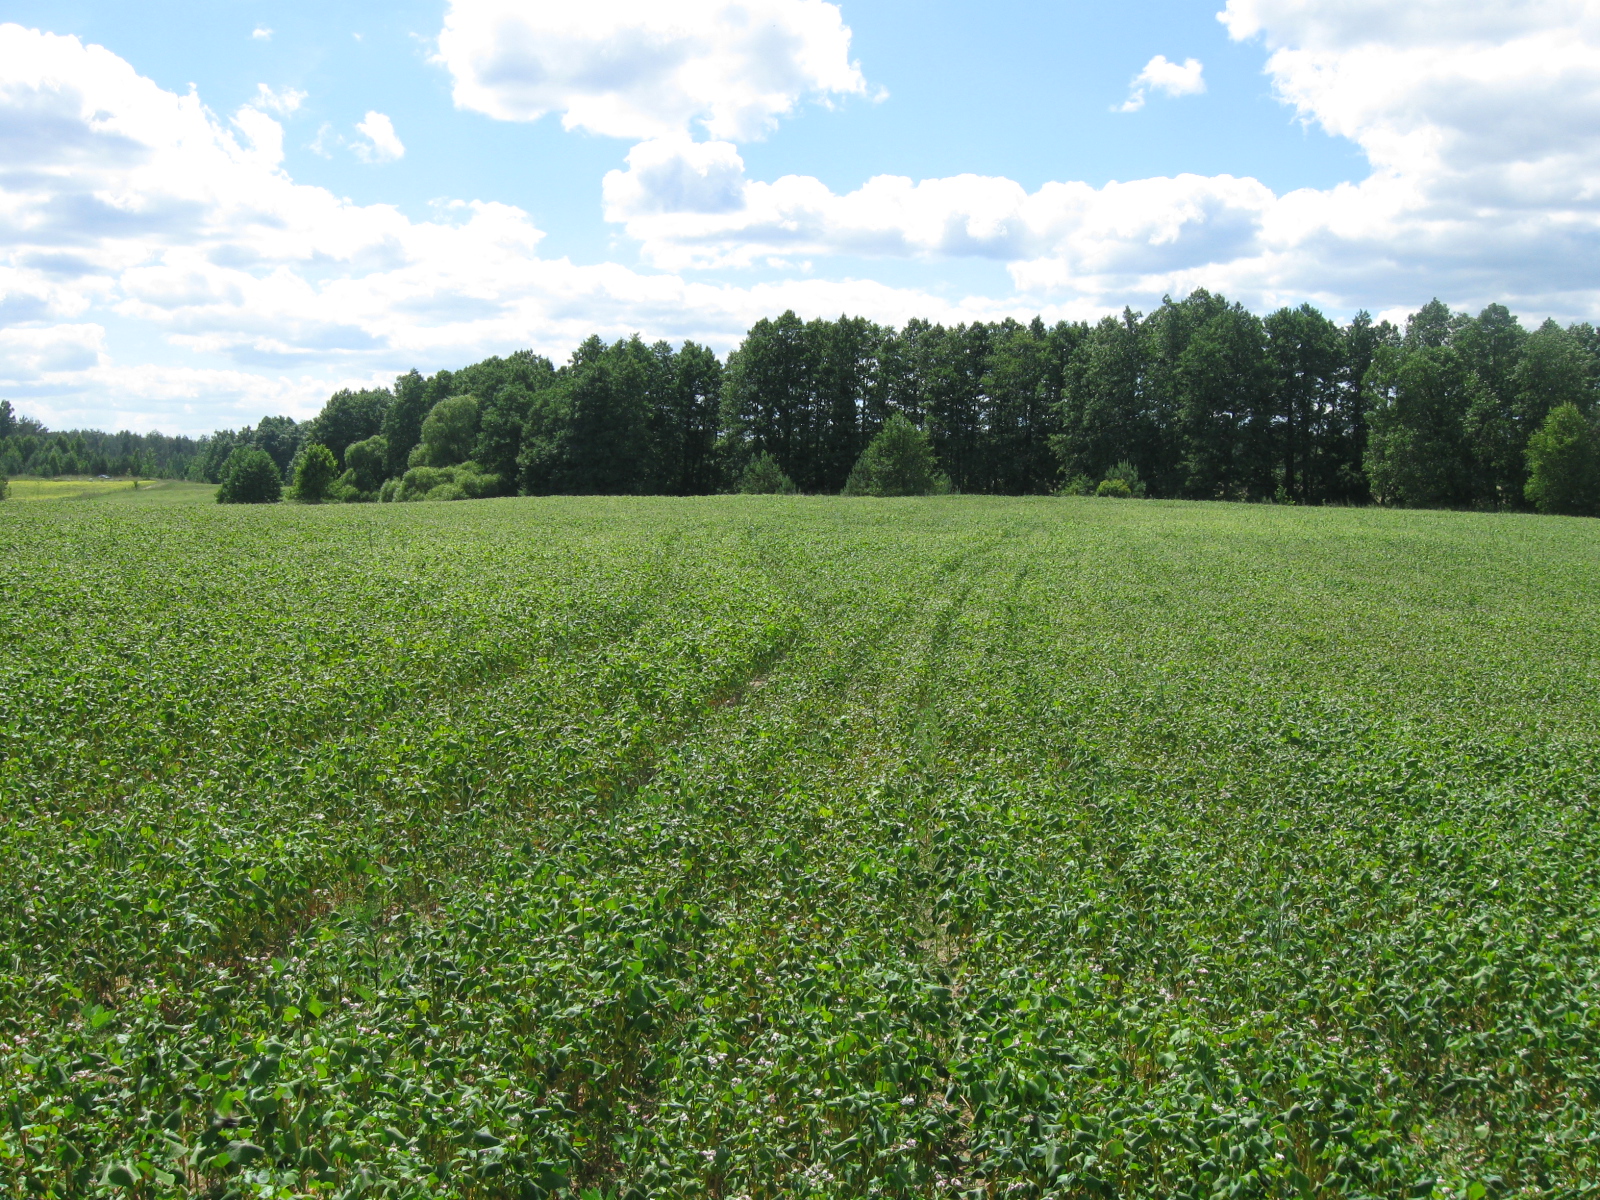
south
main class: Cropland
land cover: Other cereals
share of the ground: > 75 %
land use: Agriculture (excluding fallow land and kitchen gardens)
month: July
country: LT
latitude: 54.3385
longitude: 24.6099
